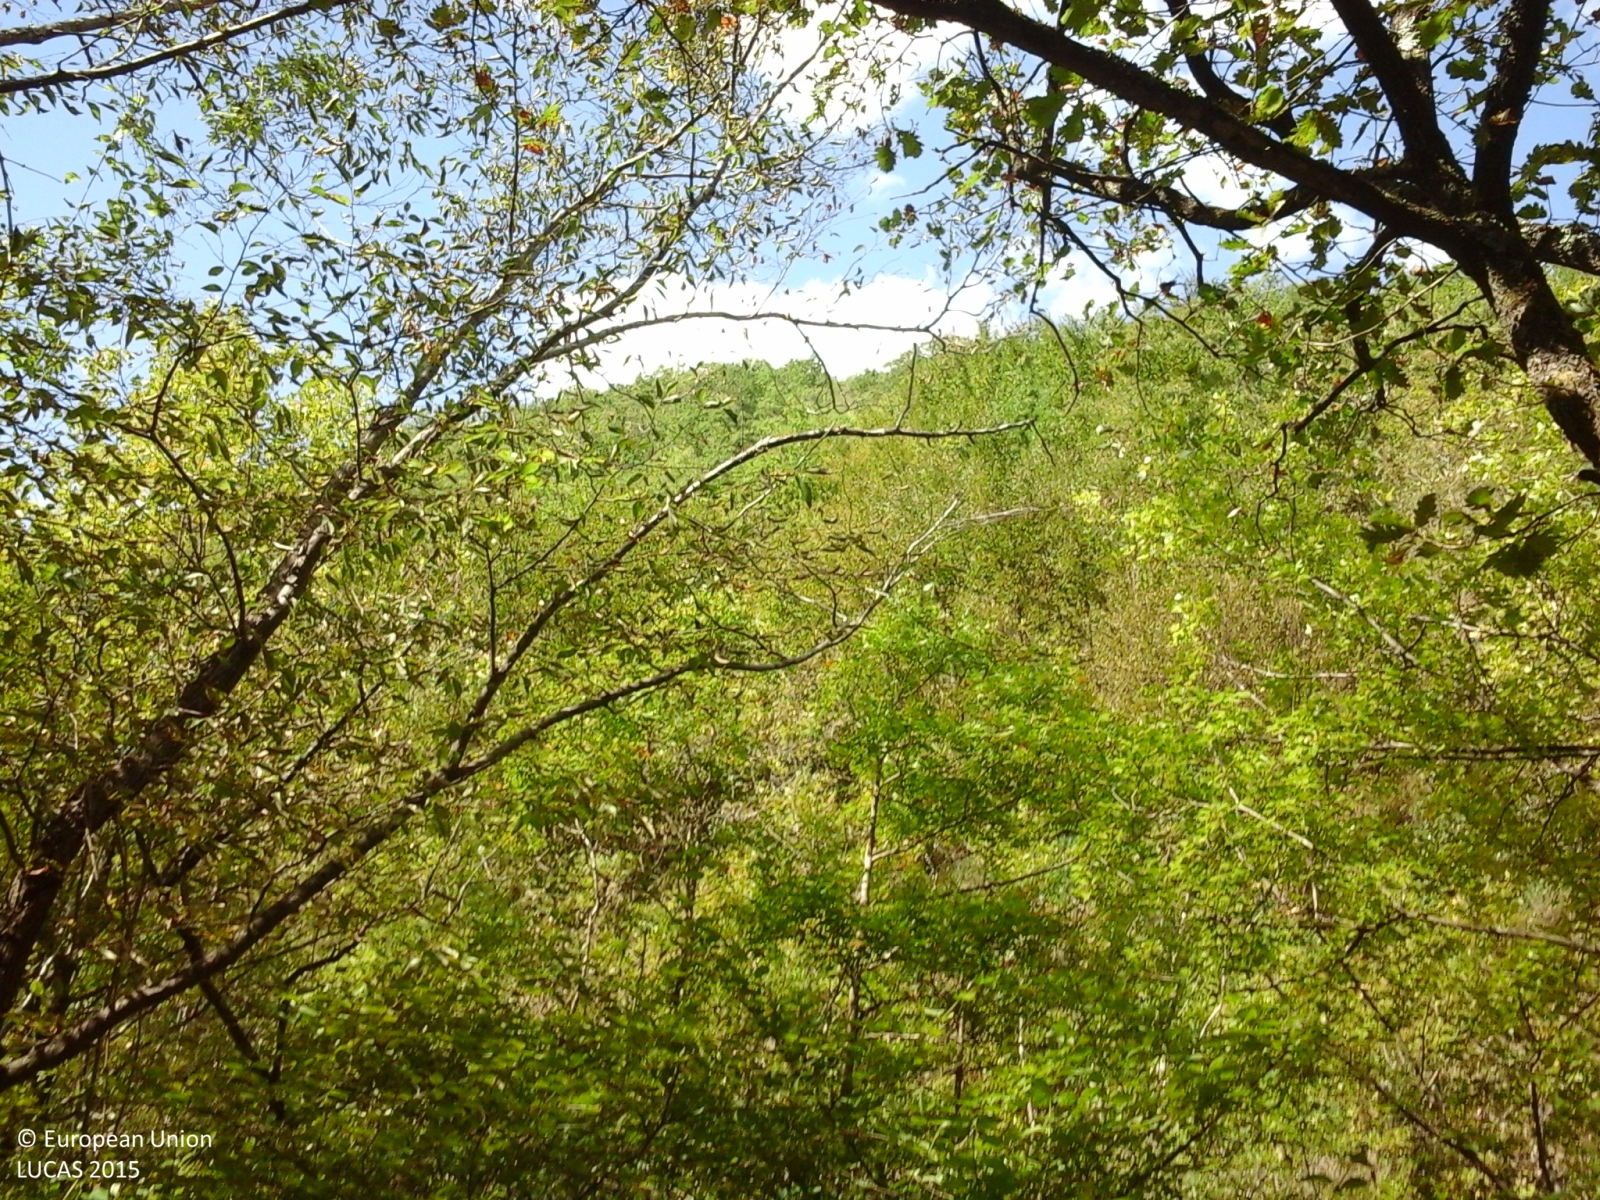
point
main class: Woodland
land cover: Broadleaved woodland
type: mesophytic deciduous forest
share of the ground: > 75 %
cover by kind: broadleaved forest trees 90 %, shrubs 10 %
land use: Forestry
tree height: > 5 m
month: September
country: IT
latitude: 43.2741
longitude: 13.1337
